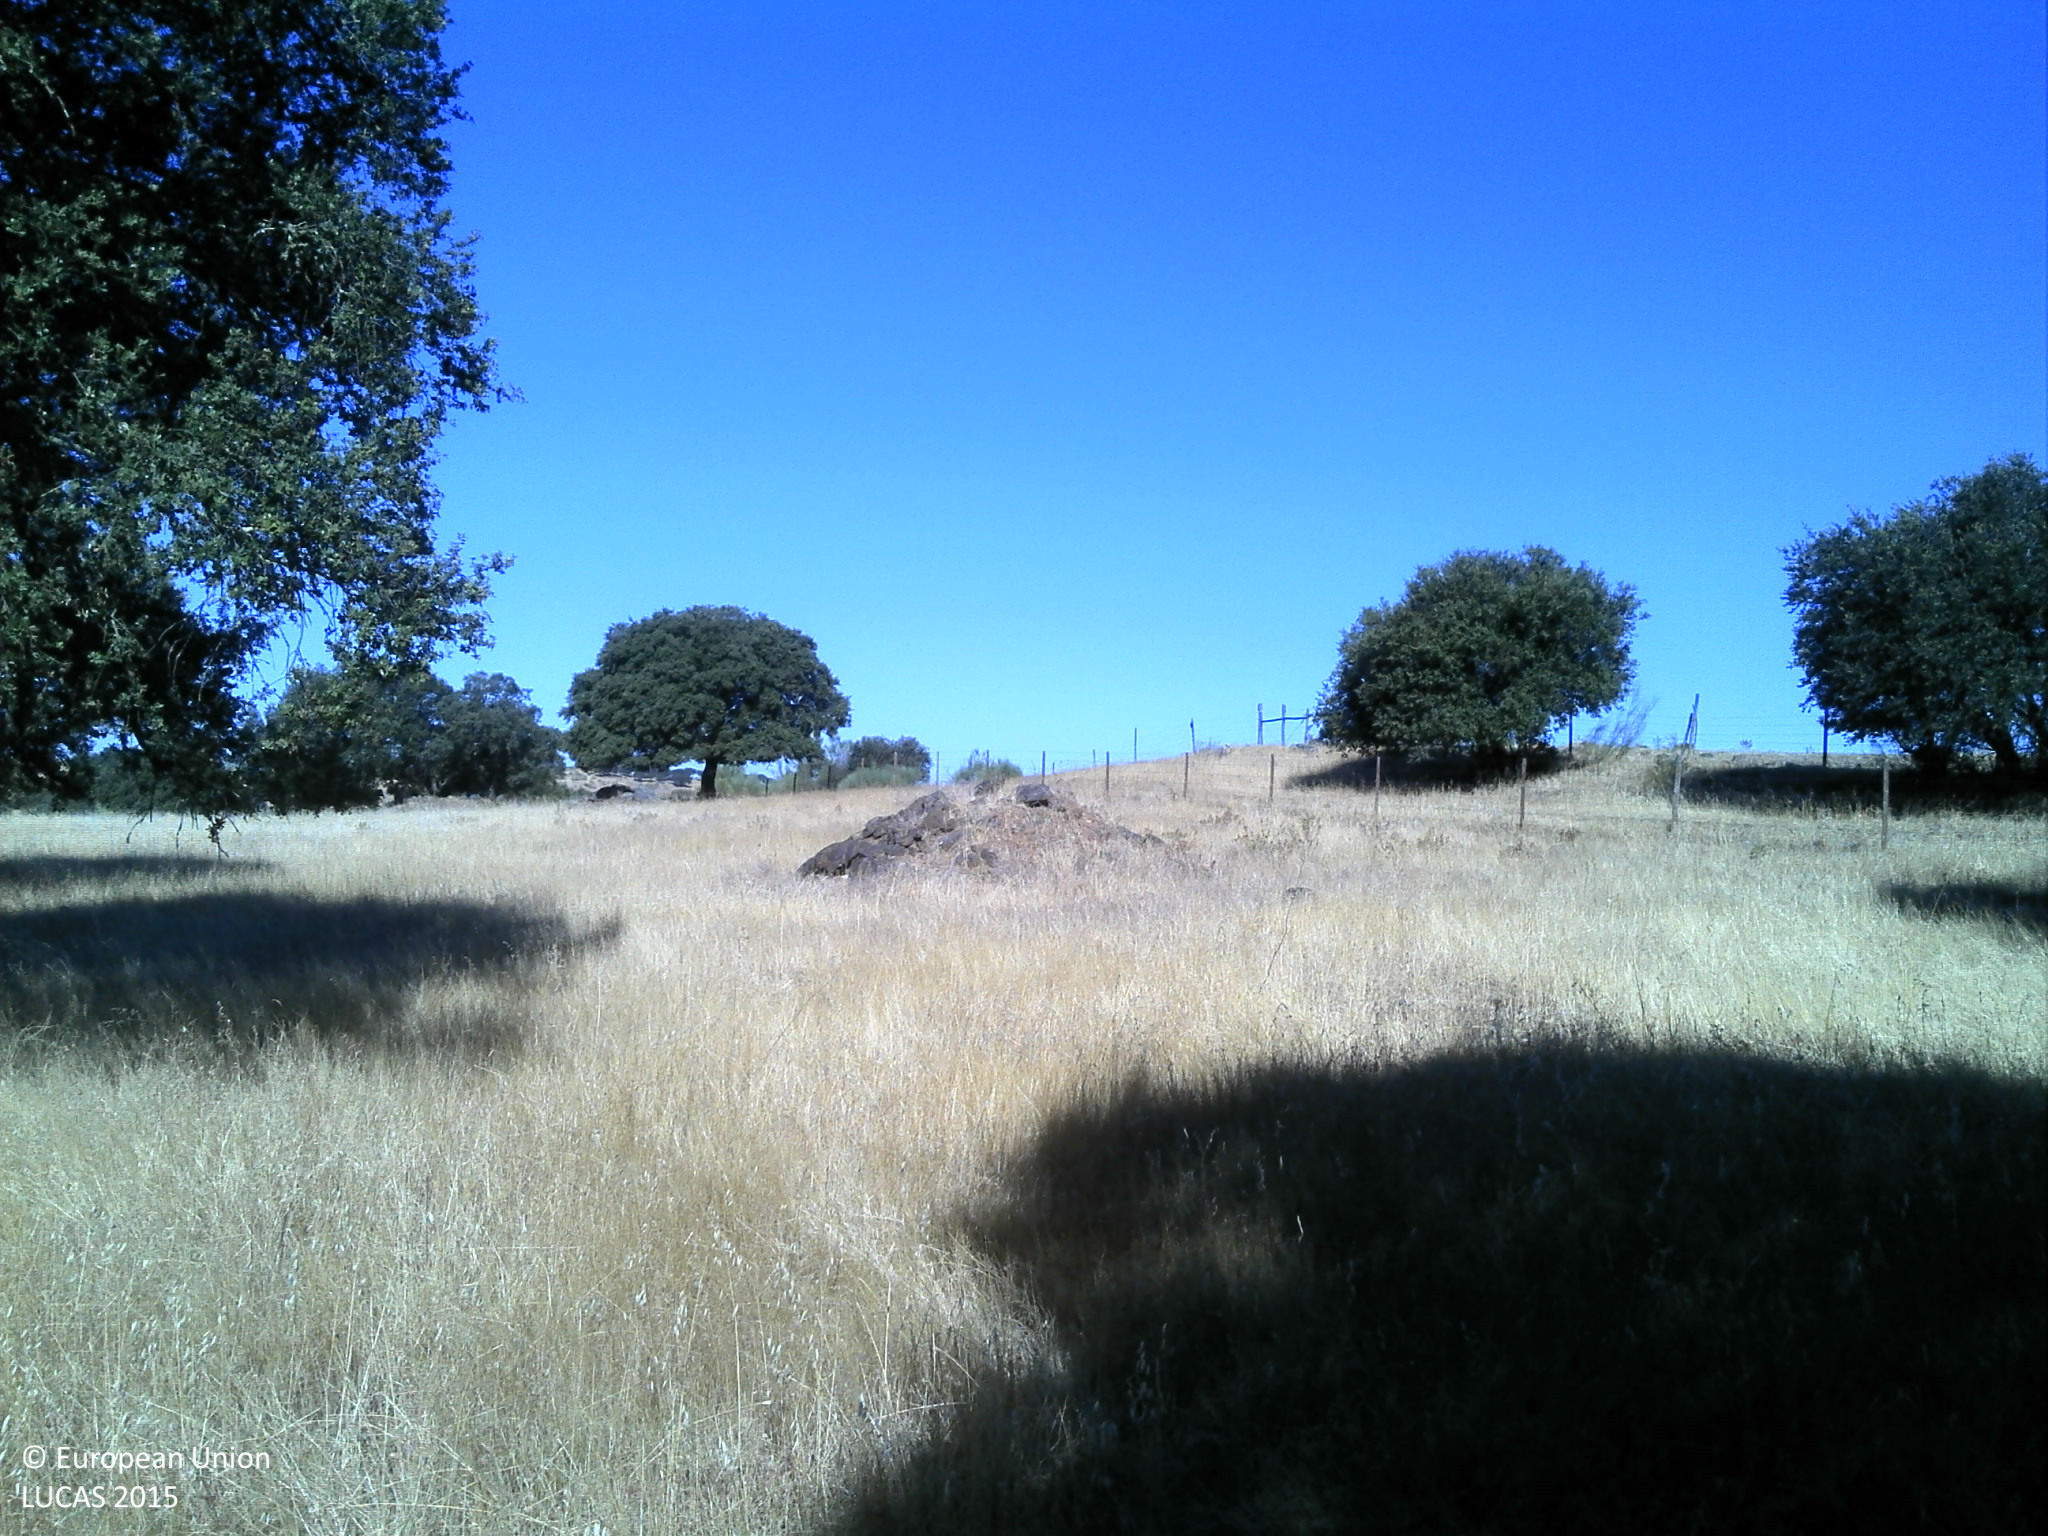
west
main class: Woodland
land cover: Broadleaved woodland
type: broadleaved evergreen forest
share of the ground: 10 - 25 %
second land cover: Grassland without tree/shrub cover
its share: 50 - 75 %
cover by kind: herbaceous plants 60 %, unconsolidated bare surface 25 %, broadleaved forest trees 15 %
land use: Forestry
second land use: Agriculture (excluding fallow land and kitchen gardens)
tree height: > 5 m
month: July
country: PT
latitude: 38.9612
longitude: -7.3795
